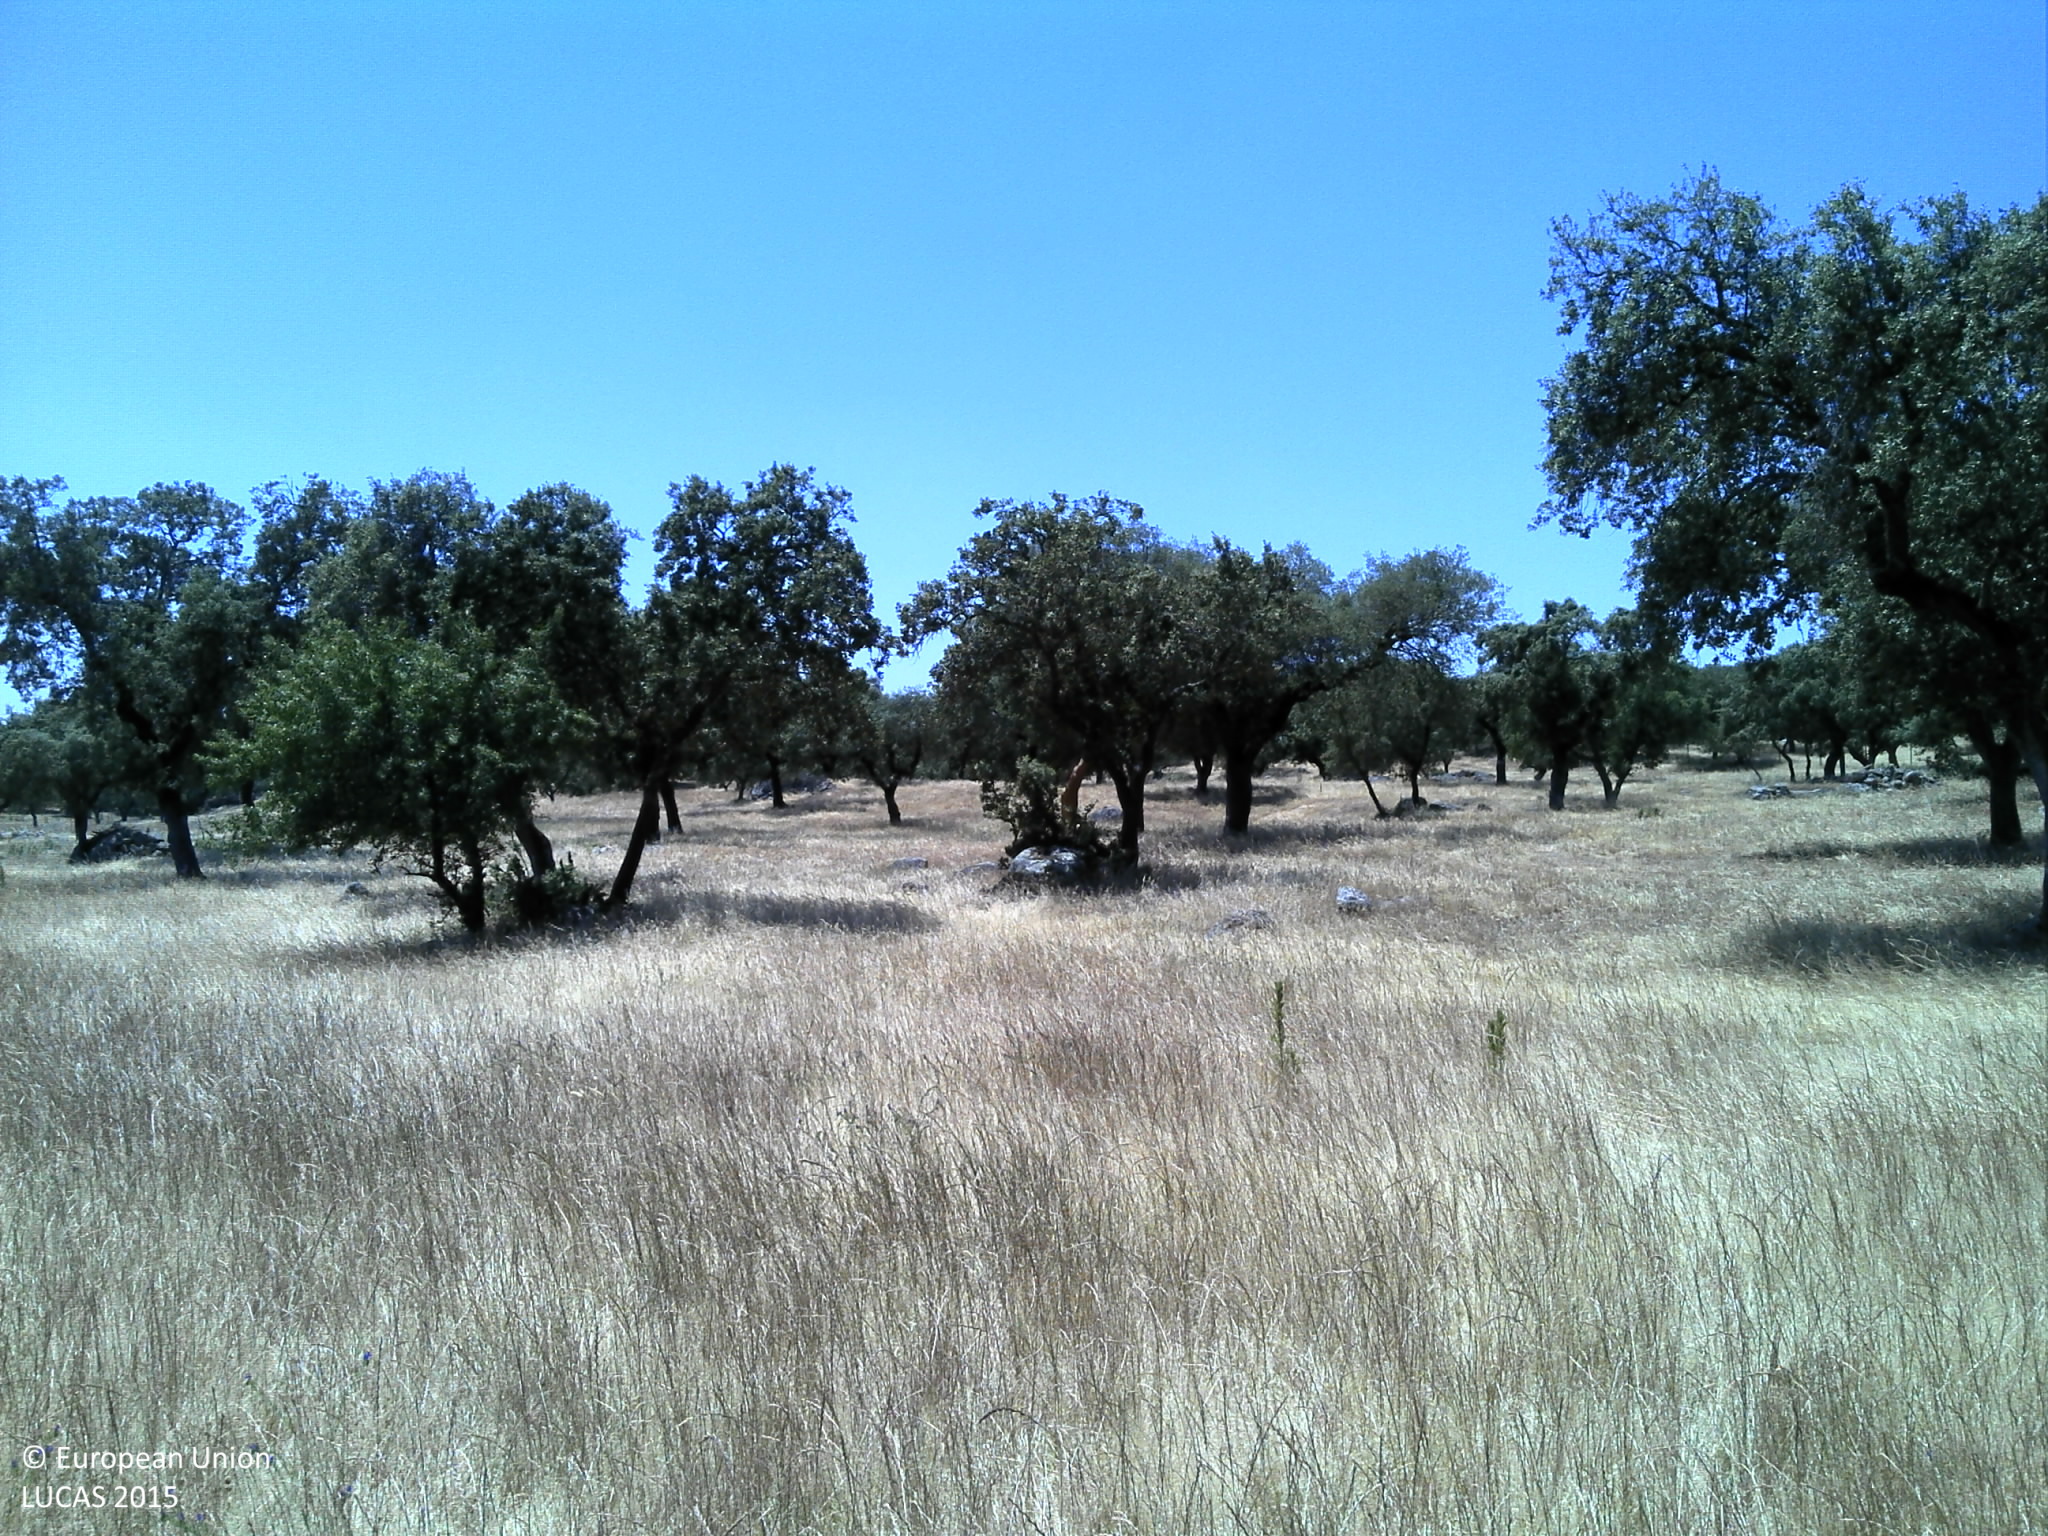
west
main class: Grassland
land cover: Grassland without tree/shrub cover
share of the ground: > 75 %
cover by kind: herbaceous plants 90 %, unconsolidated bare surface 10 %
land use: Agriculture (excluding fallow land and kitchen gardens)
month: May
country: PT
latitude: 38.8094
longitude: -8.0940
